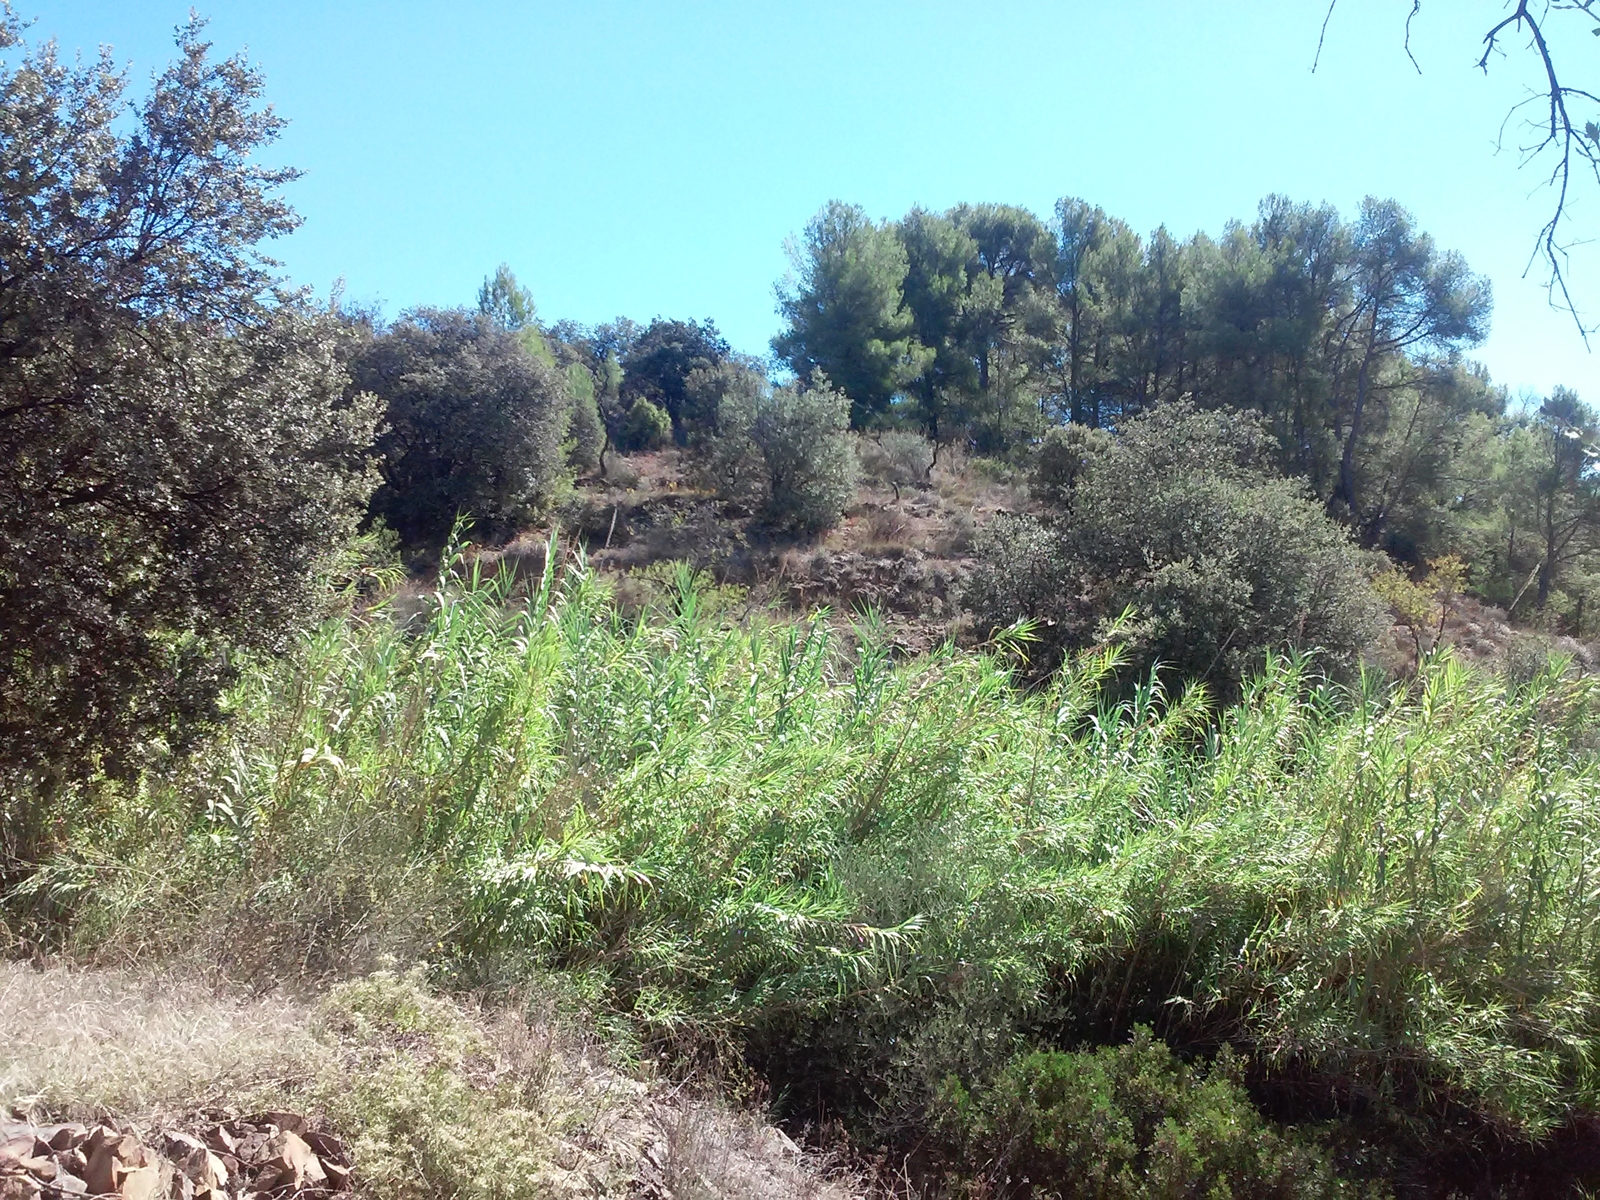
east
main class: Woodland
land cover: Pine dominated mixed woodland
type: coniferous forest of the mediterranean region
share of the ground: 50 - 75 %
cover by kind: shrubs 50 %, coniferous forest trees 25 %, broadleaved forest trees 25 %
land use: Semi-natural and natural areas not in use
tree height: < 5 m
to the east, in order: Pine dominated mixed woodland; Tracks; Pine dominated mixed woodland; Vineyards; Single bushes/trees; Vineyards; Tracks; Vineyards
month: September
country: ES
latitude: 41.2164
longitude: 0.7954
